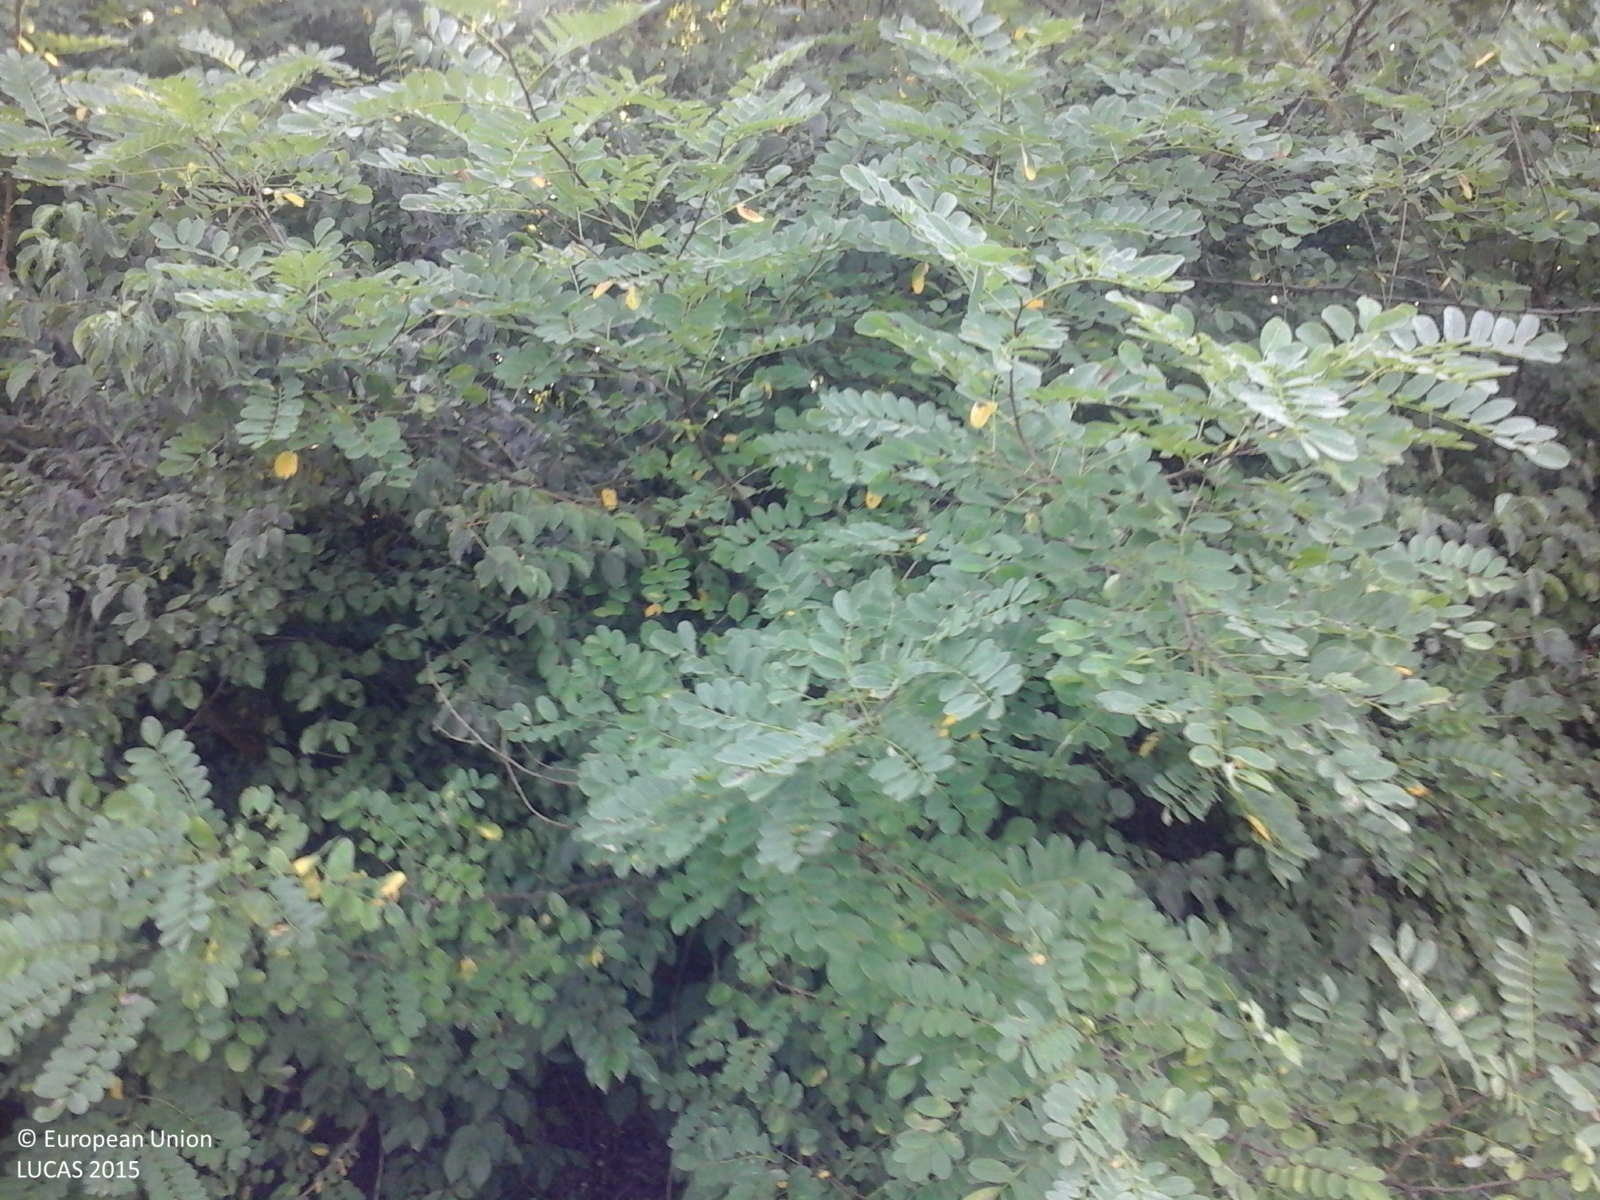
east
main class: Woodland
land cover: Broadleaved woodland
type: broadleaved evergreen forest
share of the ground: > 75 %
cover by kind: broadleaved forest trees 100 %
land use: Forestry
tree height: > 5 m
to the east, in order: Broadleaved woodland; Ditches and canals; Broadleaved woodland; Electric lines; Broadleaved woodland; Tracks; Broadleaved woodland; Fences; Maize
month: August
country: RO
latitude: 46.2744
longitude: 22.3104
